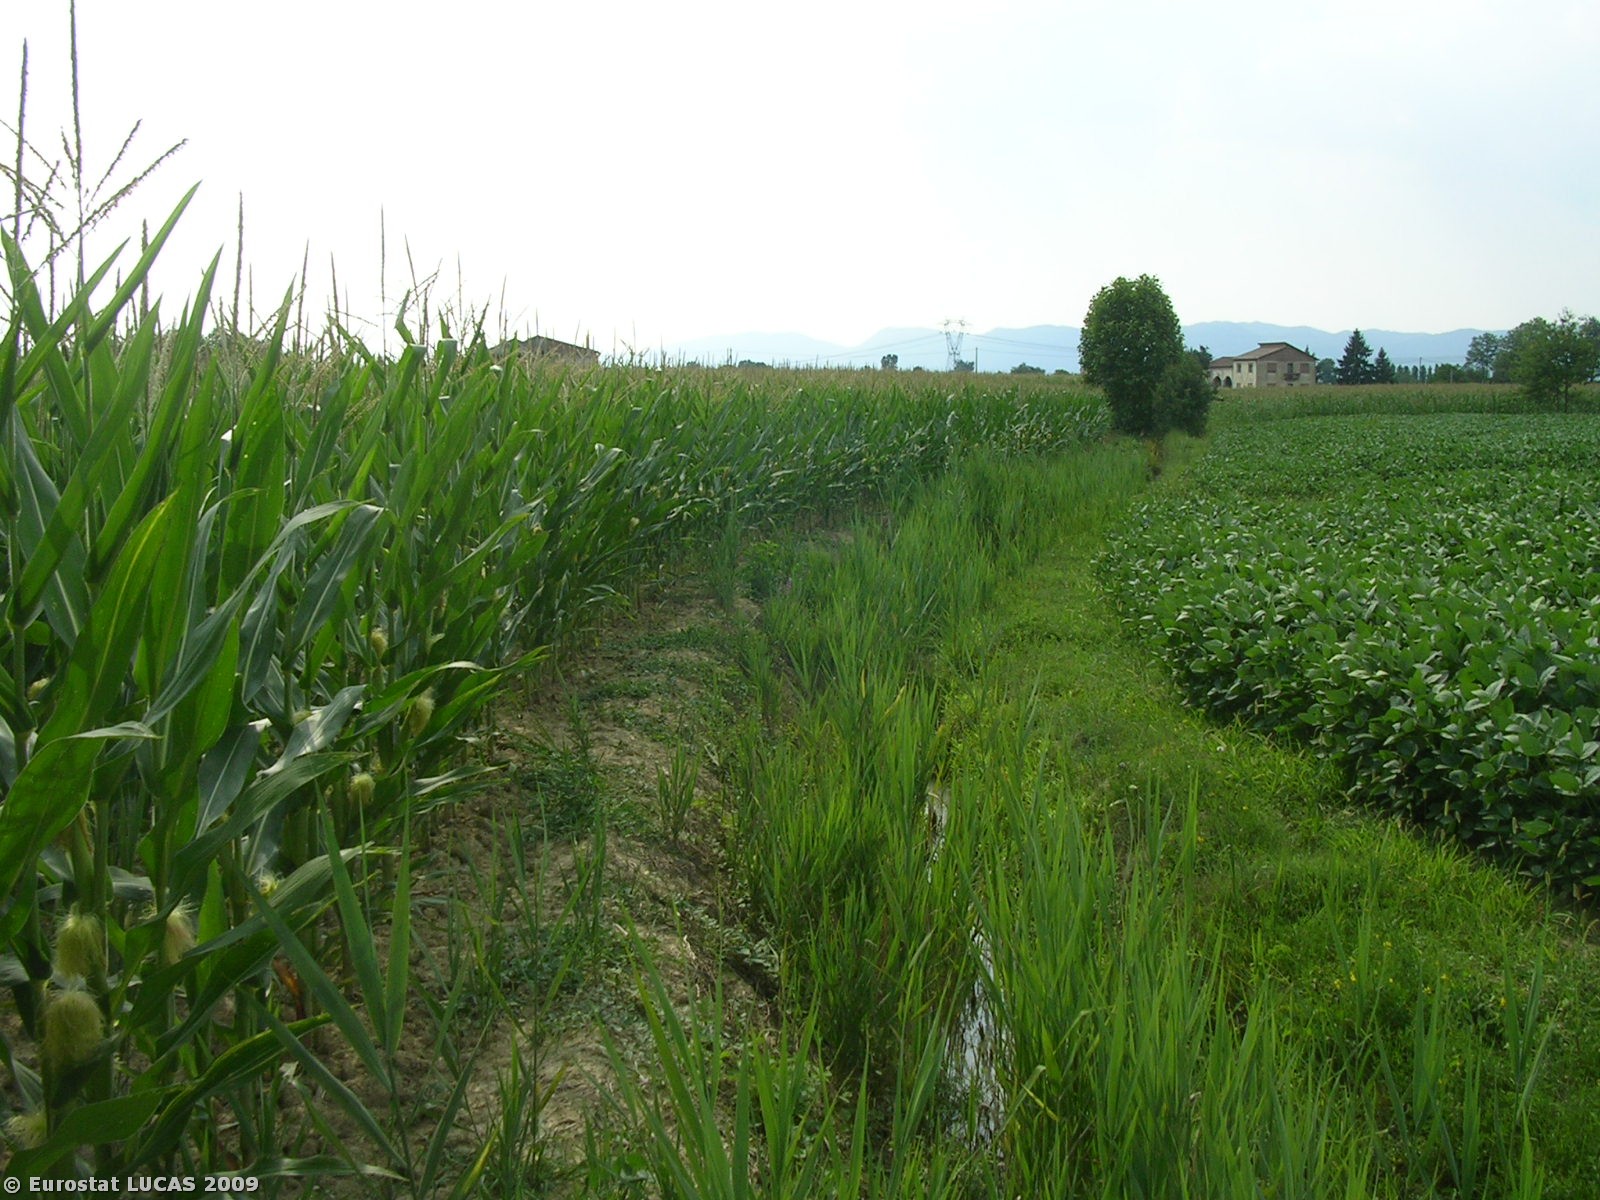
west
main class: Cropland
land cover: Soya
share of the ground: > 75 %
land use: Agriculture (excluding fallow land and kitchen gardens)
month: July
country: IT
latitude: 45.4011
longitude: 11.6708
